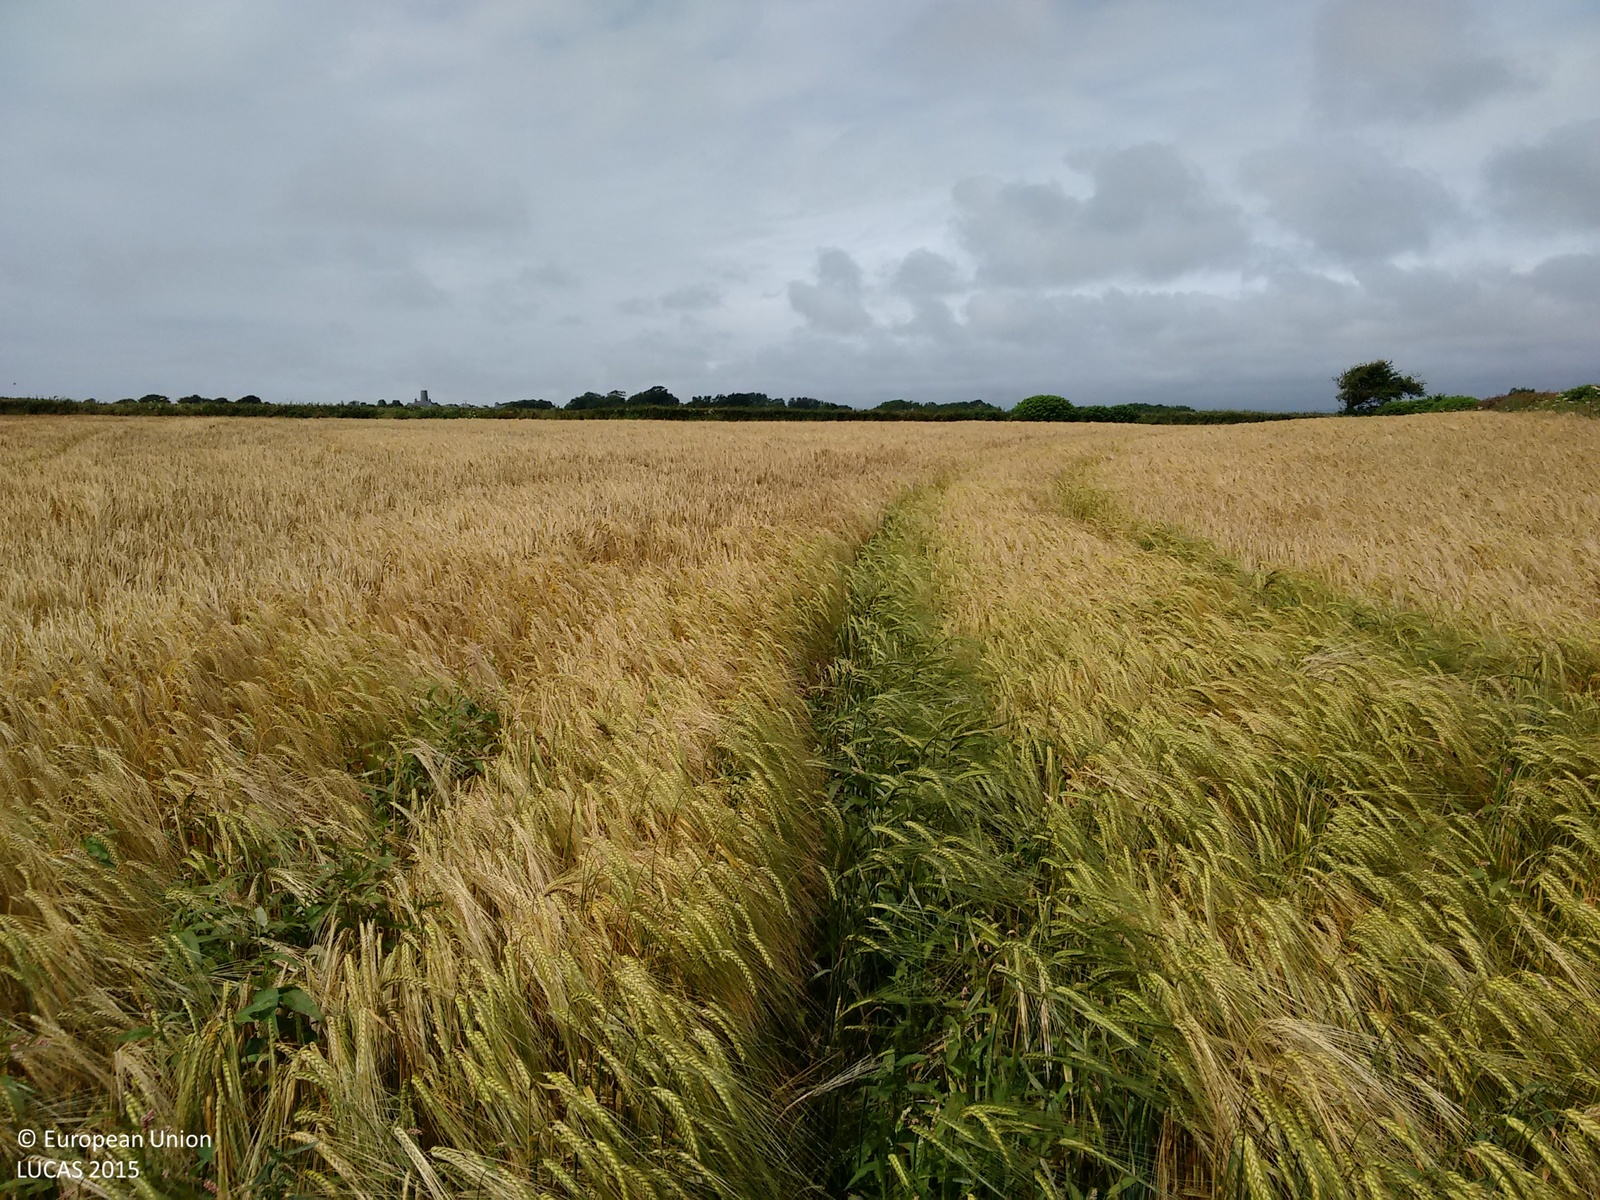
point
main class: Cropland
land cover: Barley
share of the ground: > 75 %
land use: Agriculture (excluding fallow land and kitchen gardens)
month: July
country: GB
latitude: 51.4334
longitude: -3.5346
